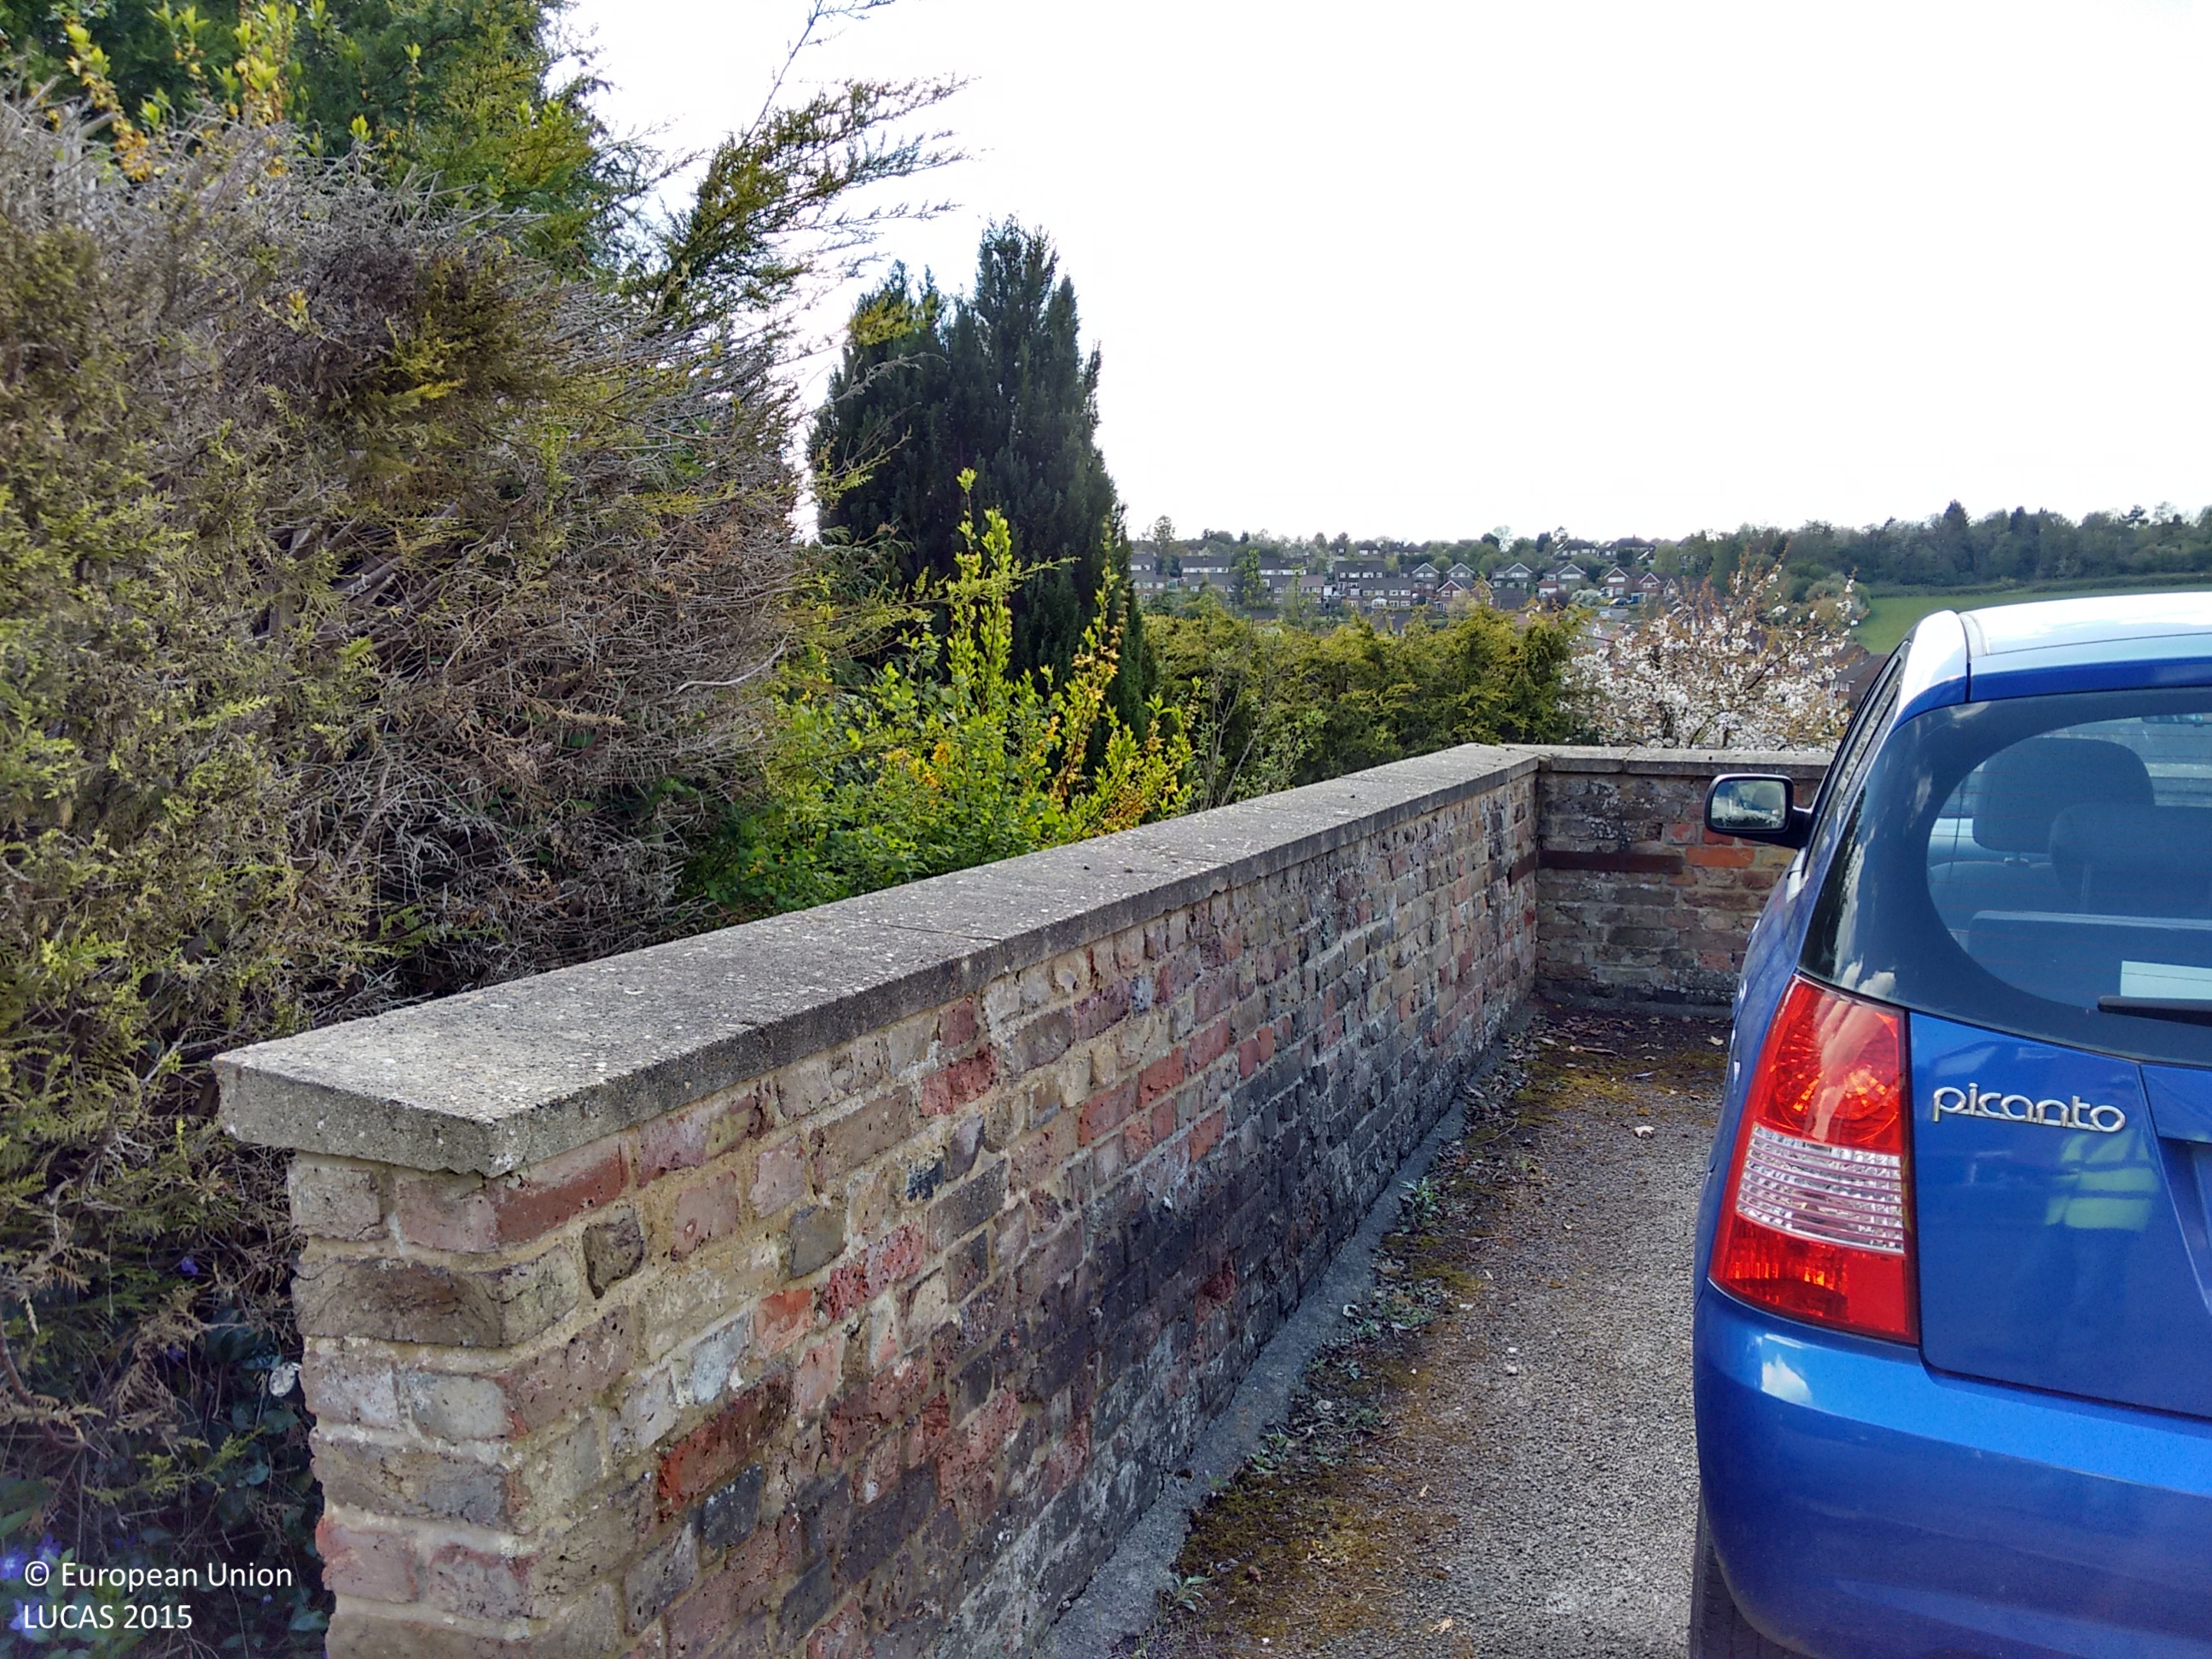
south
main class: Woodland
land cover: Broadleaved woodland
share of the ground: > 75 %
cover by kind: broadleaved forest trees 50 %, herbaceous plants 50 %
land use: Residential
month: April
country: GB
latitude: 51.7182
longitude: -0.6209
